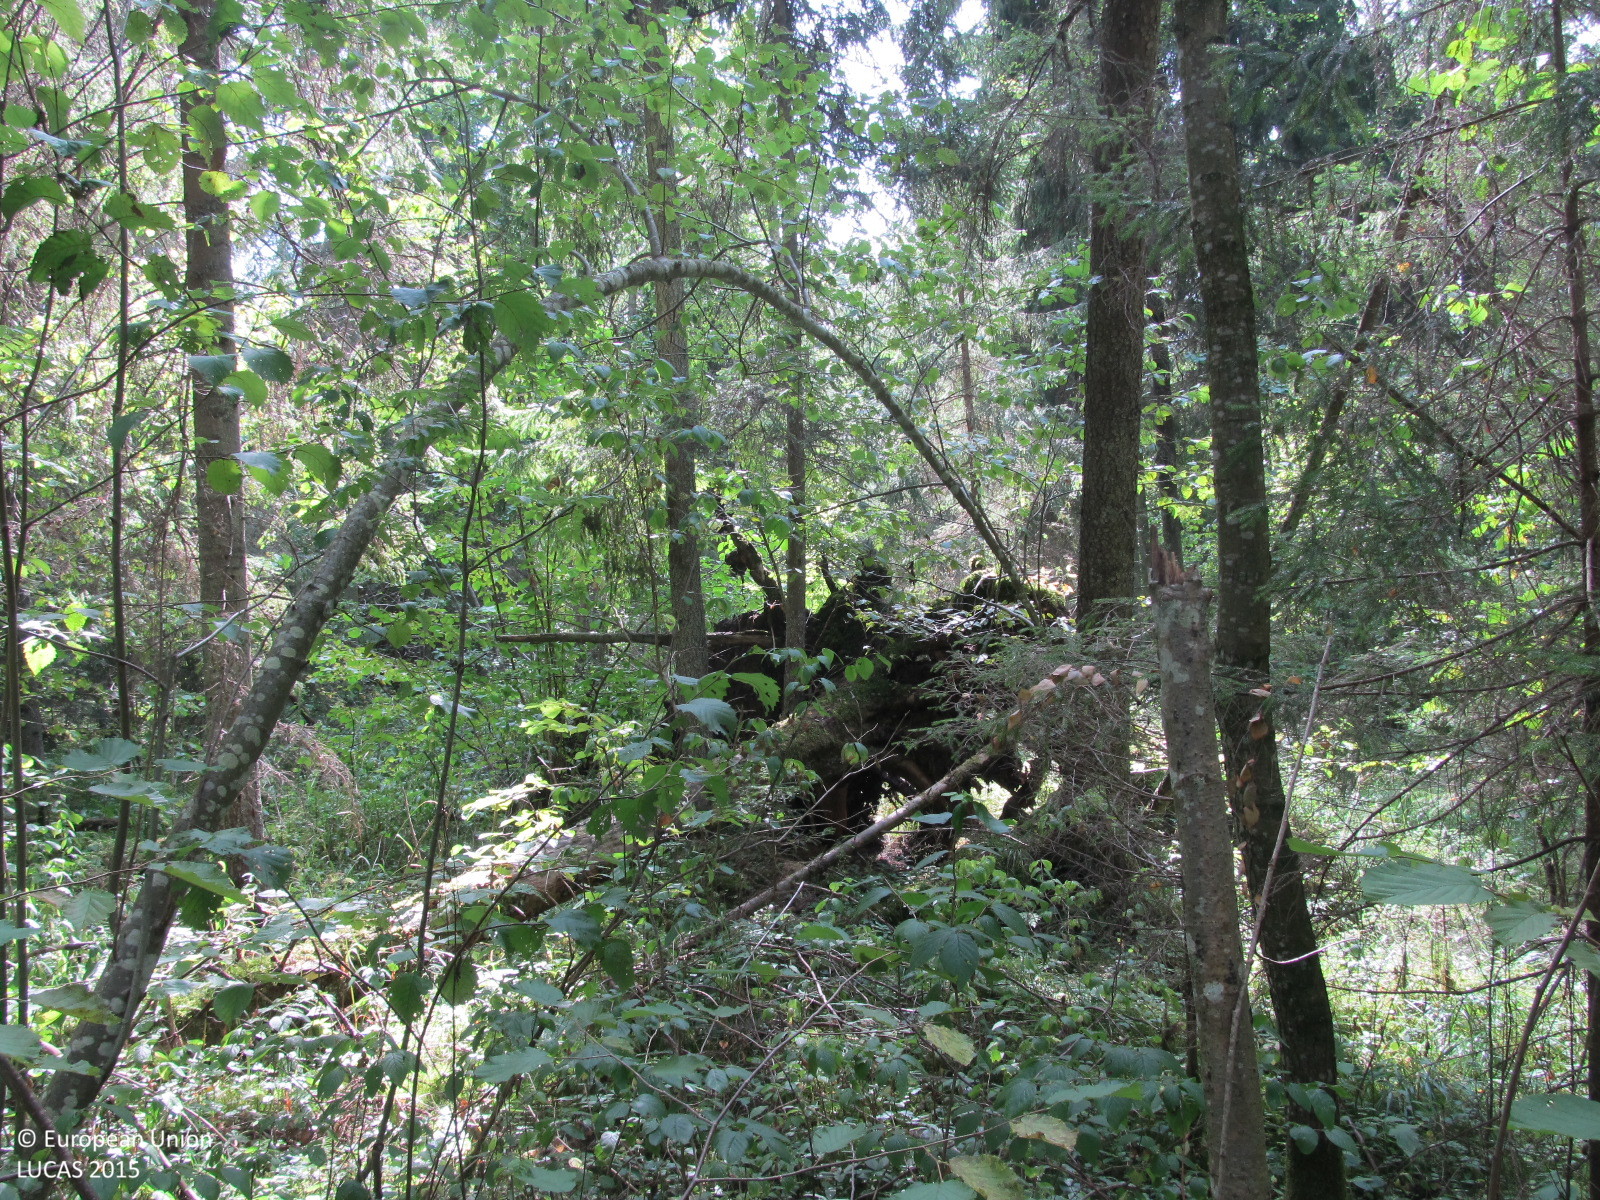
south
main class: Woodland
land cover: Spruce dominated mixed woodland
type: hemiboreal forest and nemoral coniferous forest and mixed broadleaved-coniferous forest
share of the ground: > 75 %
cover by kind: coniferous forest trees 45 %, broadleaved forest trees 40 %, herbaceous plants 10 %, shrubs 5 %
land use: Forestry
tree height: > 5 m
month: August
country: LT
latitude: 55.7782
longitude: 22.9988
